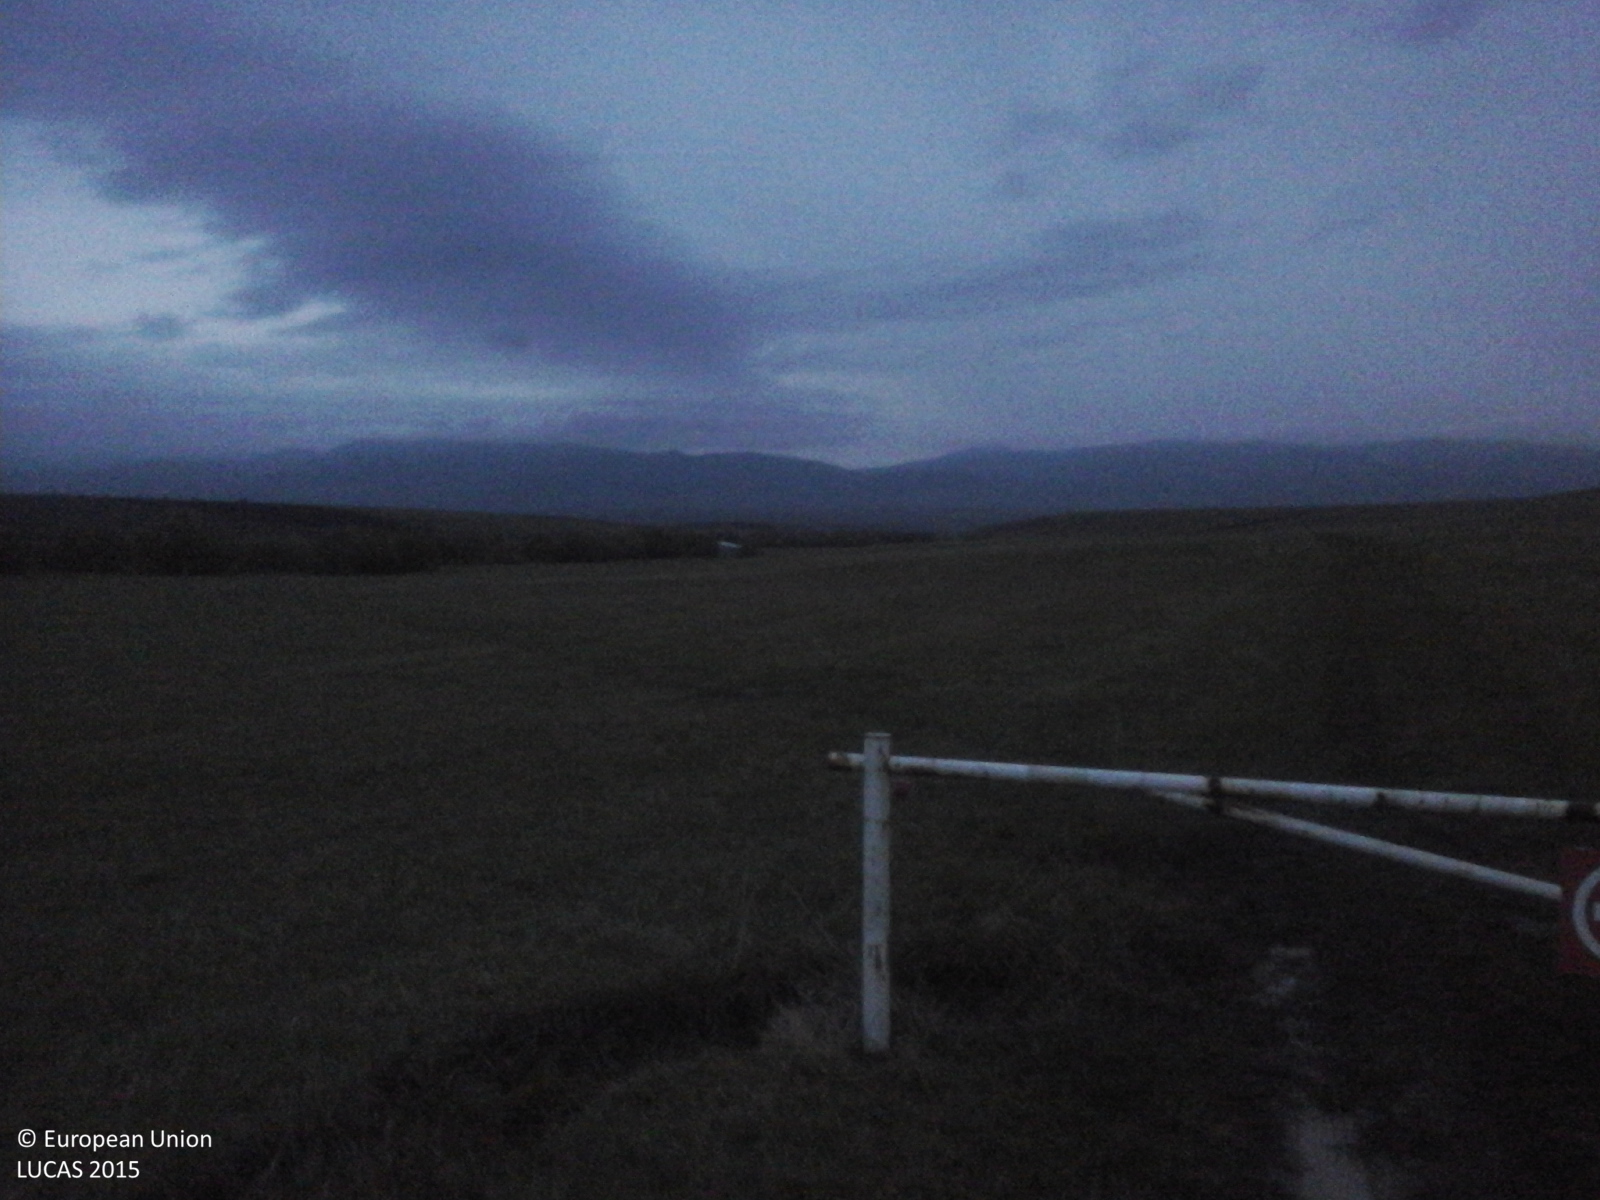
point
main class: Grassland
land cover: Grassland without tree/shrub cover
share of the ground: > 75 %
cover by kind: herbaceous plants 100 %
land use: Agriculture (excluding fallow land and kitchen gardens)
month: October
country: RO
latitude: 46.8271
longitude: 25.4878
